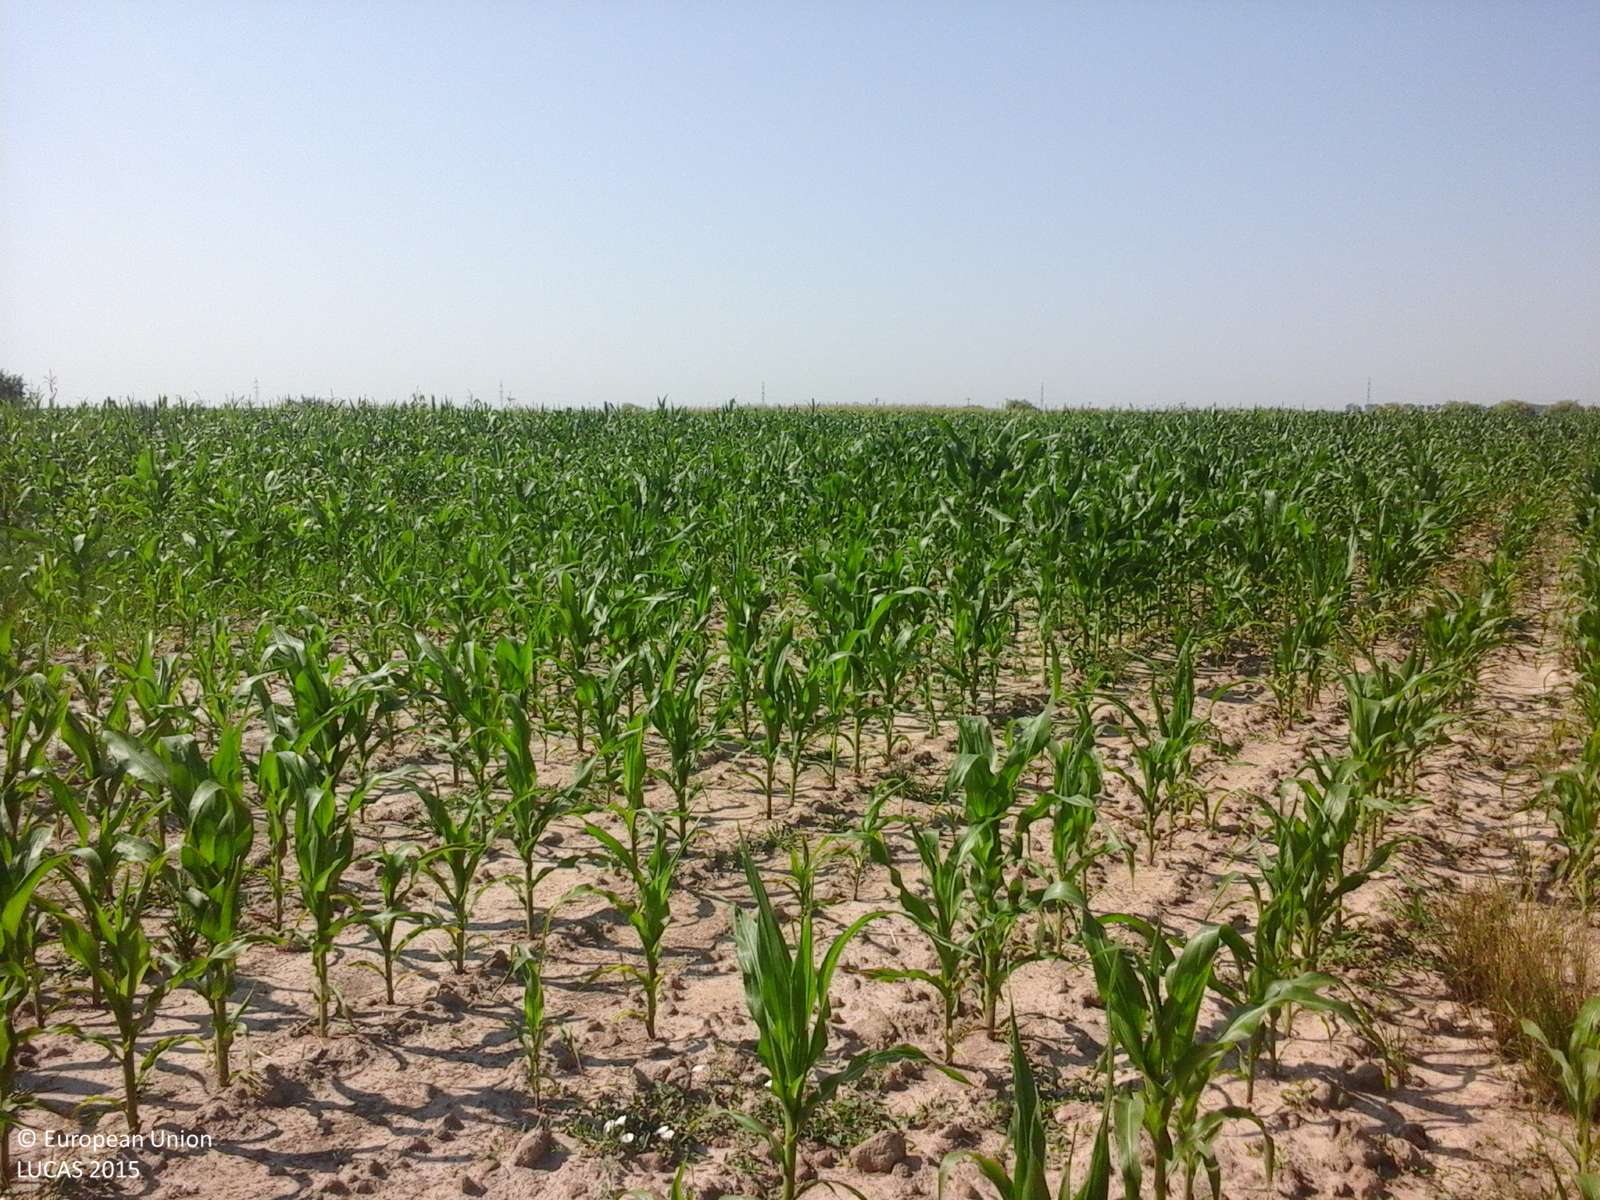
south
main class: Cropland
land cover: Maize
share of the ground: 50 - 75 %
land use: Agriculture (excluding fallow land and kitchen gardens)
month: July
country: RO
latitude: 44.7547
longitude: 25.0019
